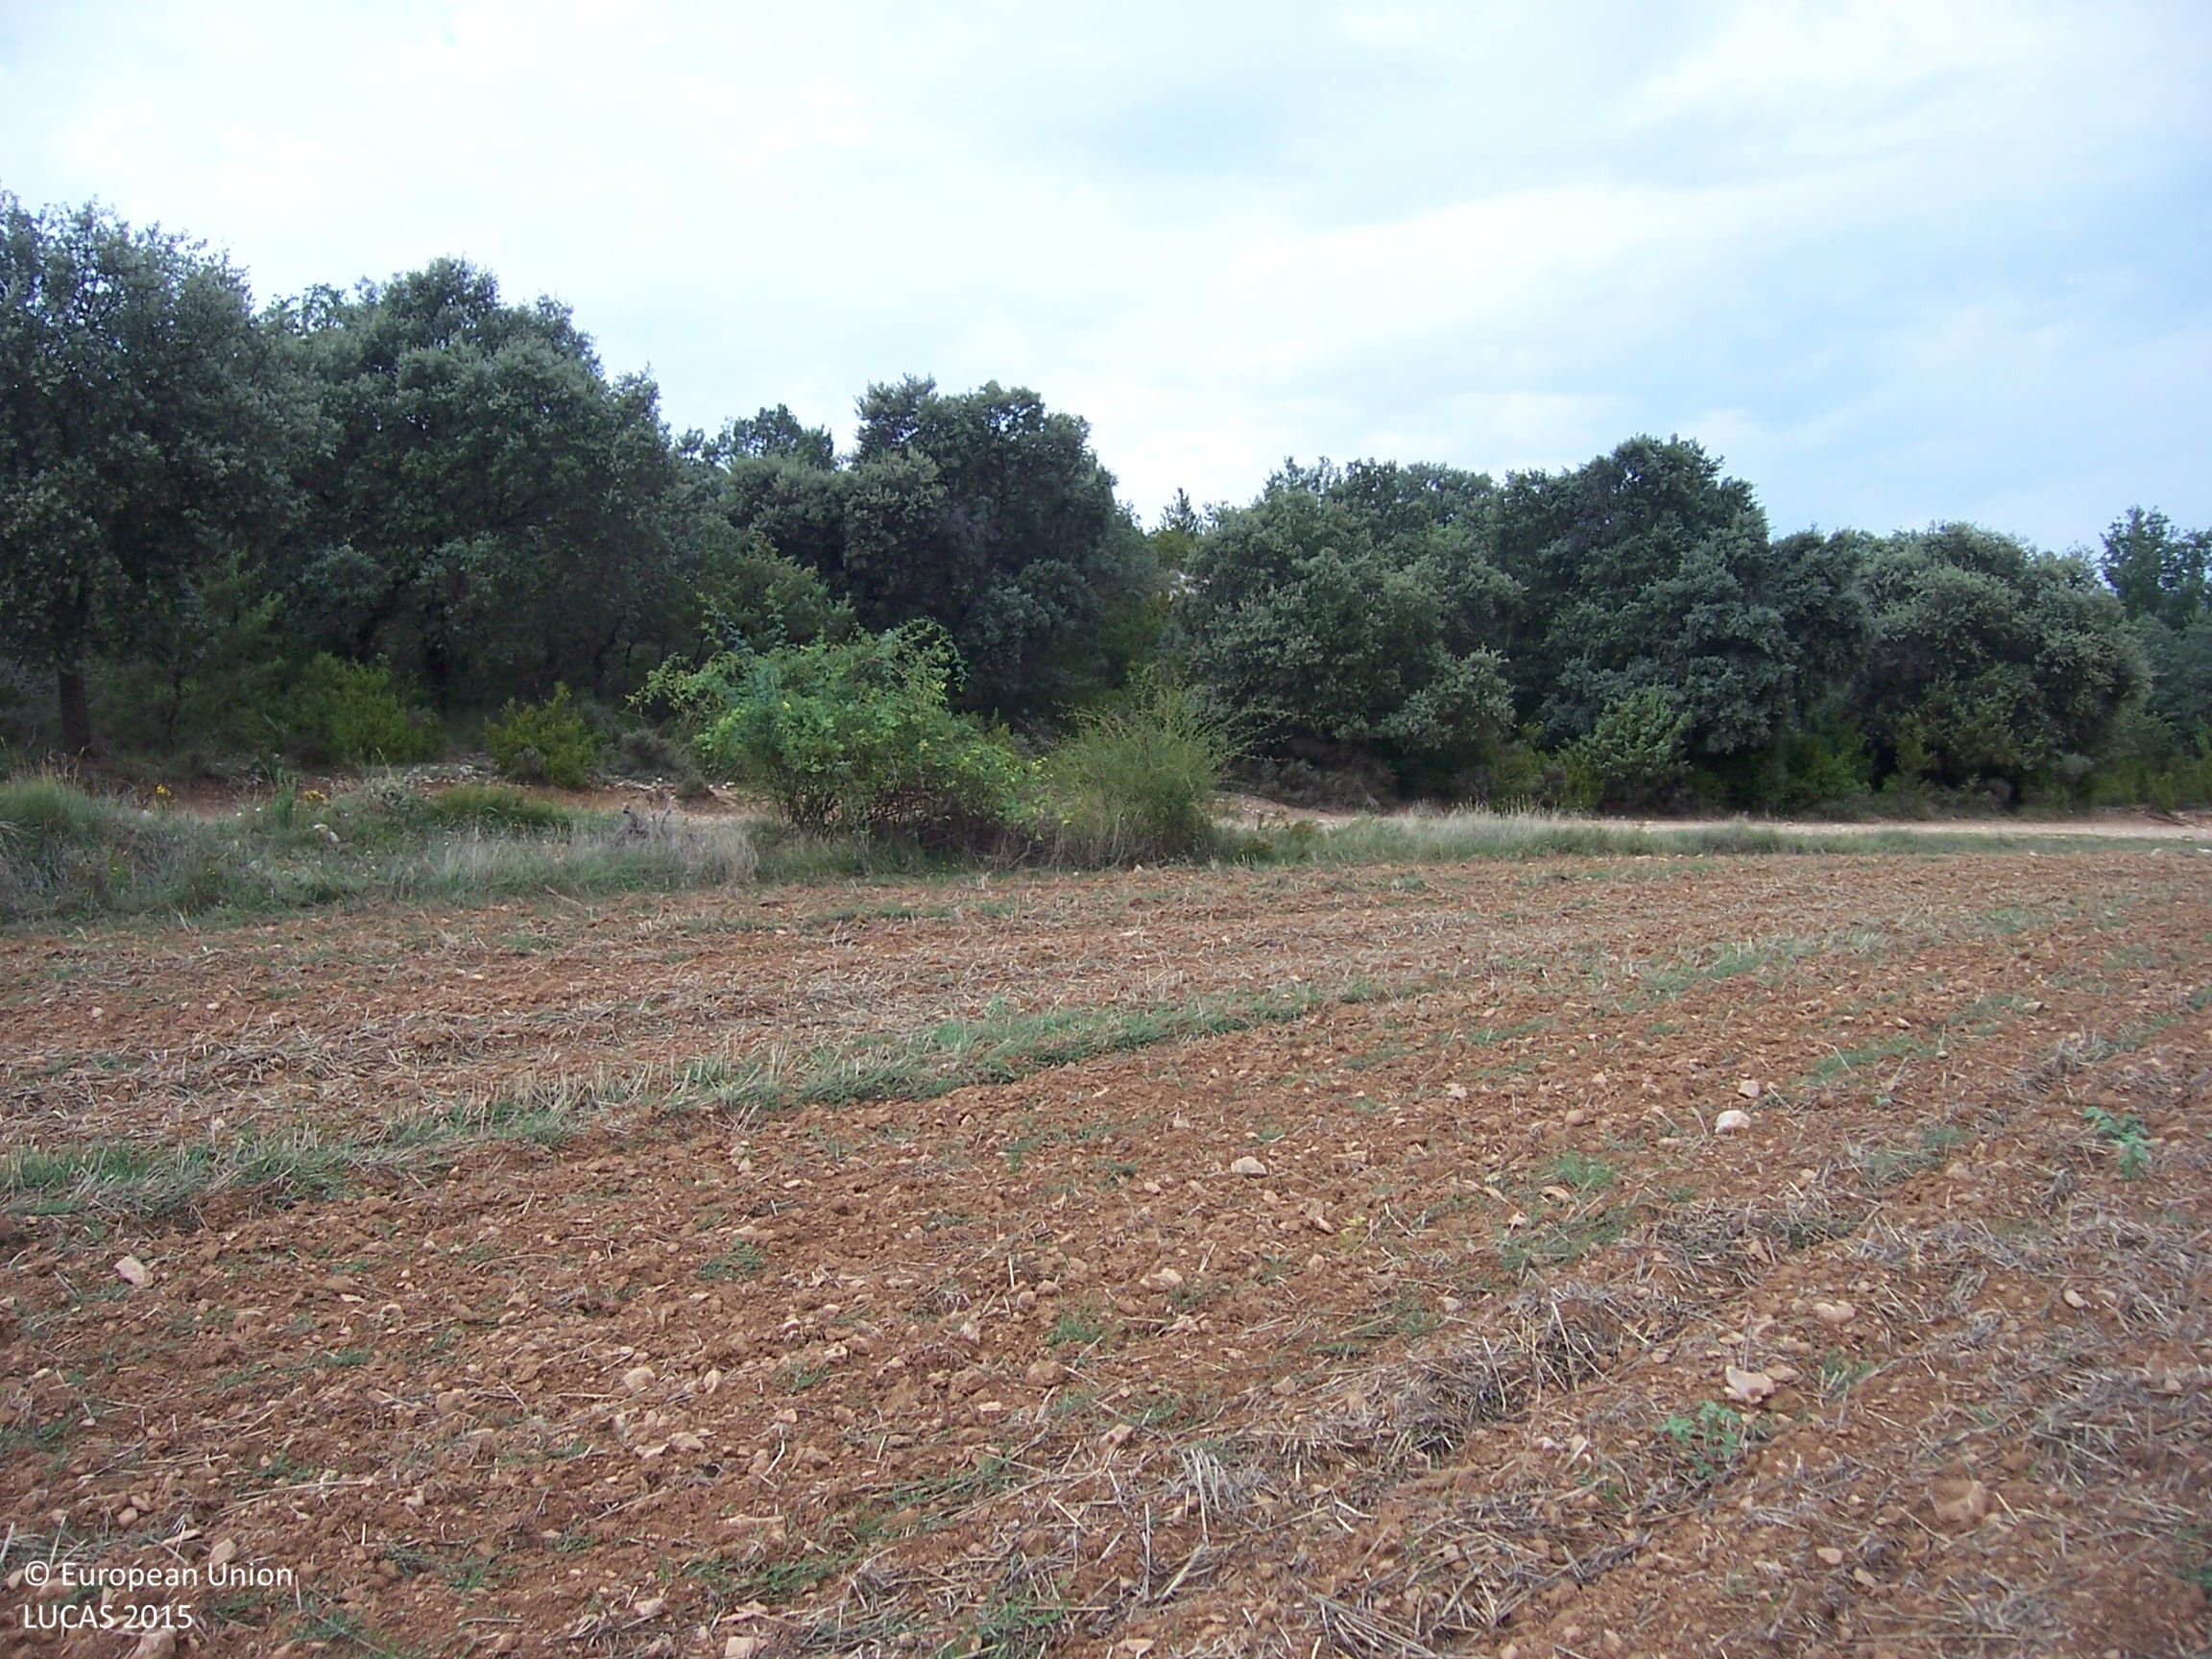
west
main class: Grassland
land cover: Spontaneously vegetated surfaces
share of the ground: > 75 %
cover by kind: unconsolidated bare surface 80 %, herbaceous plants 20 %
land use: Fallow land
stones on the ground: 10 - 25 %
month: August
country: ES
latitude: 42.1147
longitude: 0.4889
